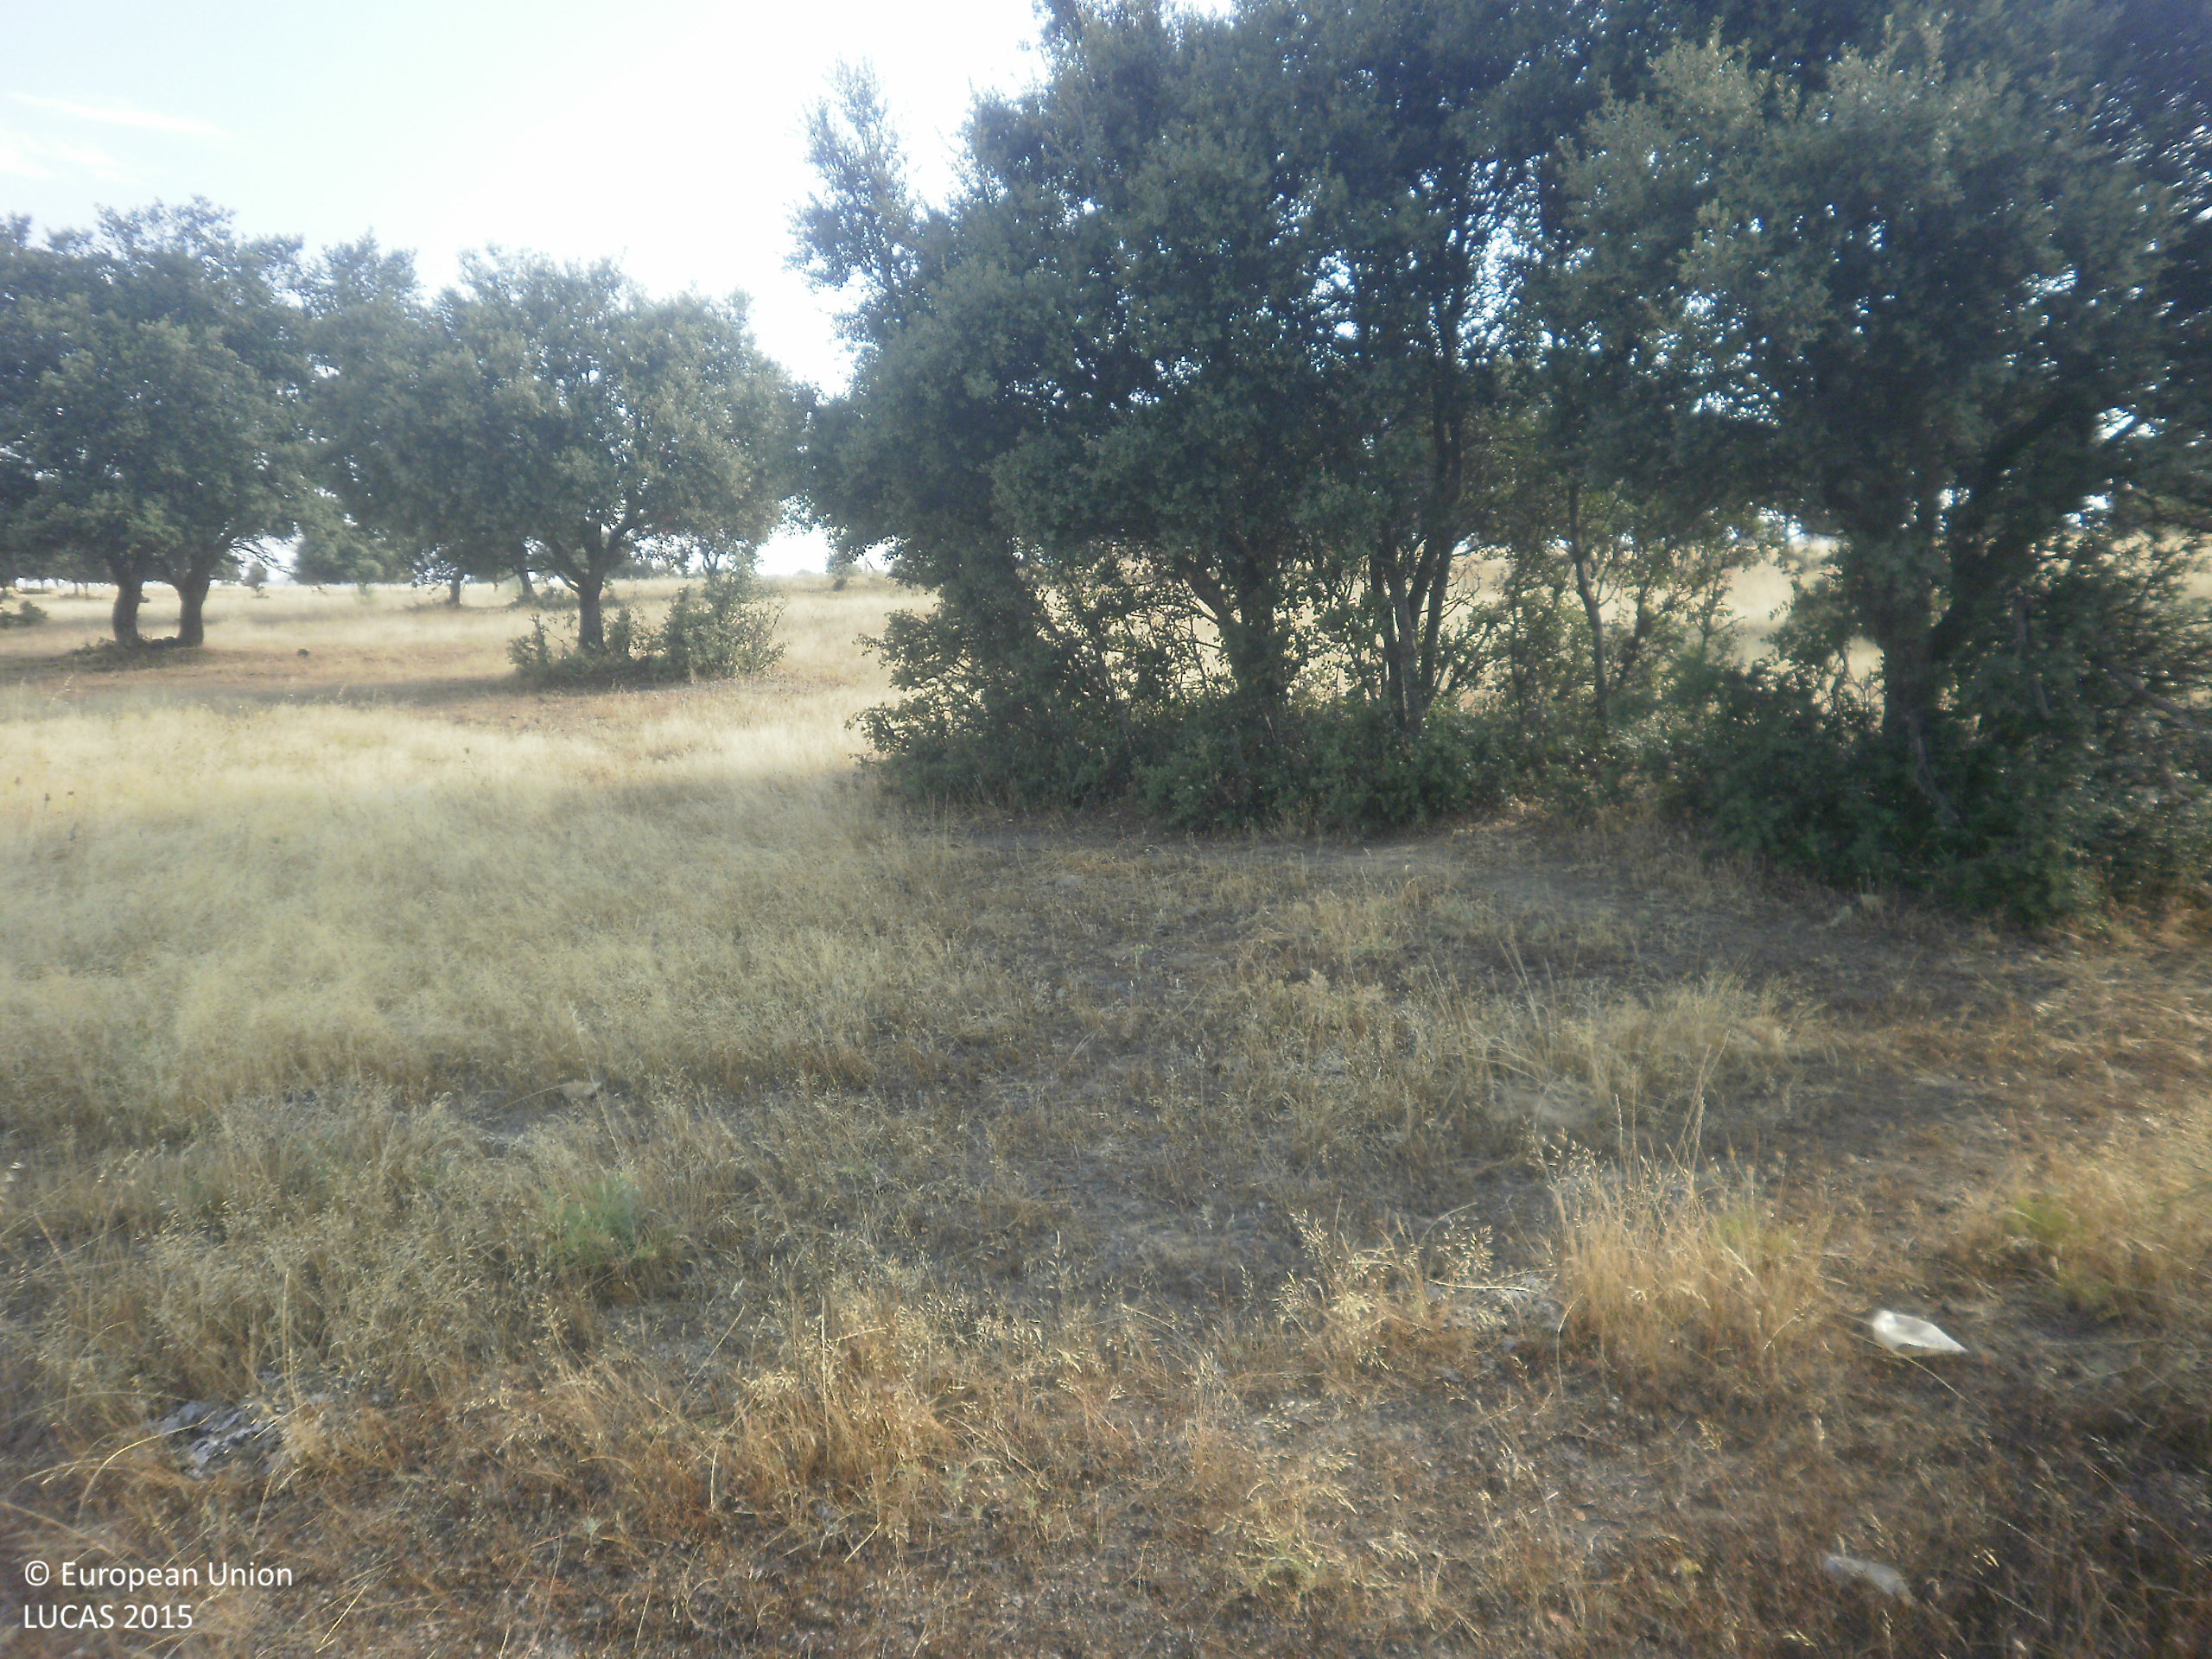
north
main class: Woodland
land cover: Broadleaved woodland
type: broadleaved evergreen forest
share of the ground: 10 - 25 %
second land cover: Grassland without tree/shrub cover
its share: 50 - 75 %
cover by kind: herbaceous plants 75 %, broadleaved forest trees 25 %
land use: Forestry
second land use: Agriculture (excluding fallow land and kitchen gardens)
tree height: > 5 m
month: June
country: ES
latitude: 39.2285
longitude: -5.8426
